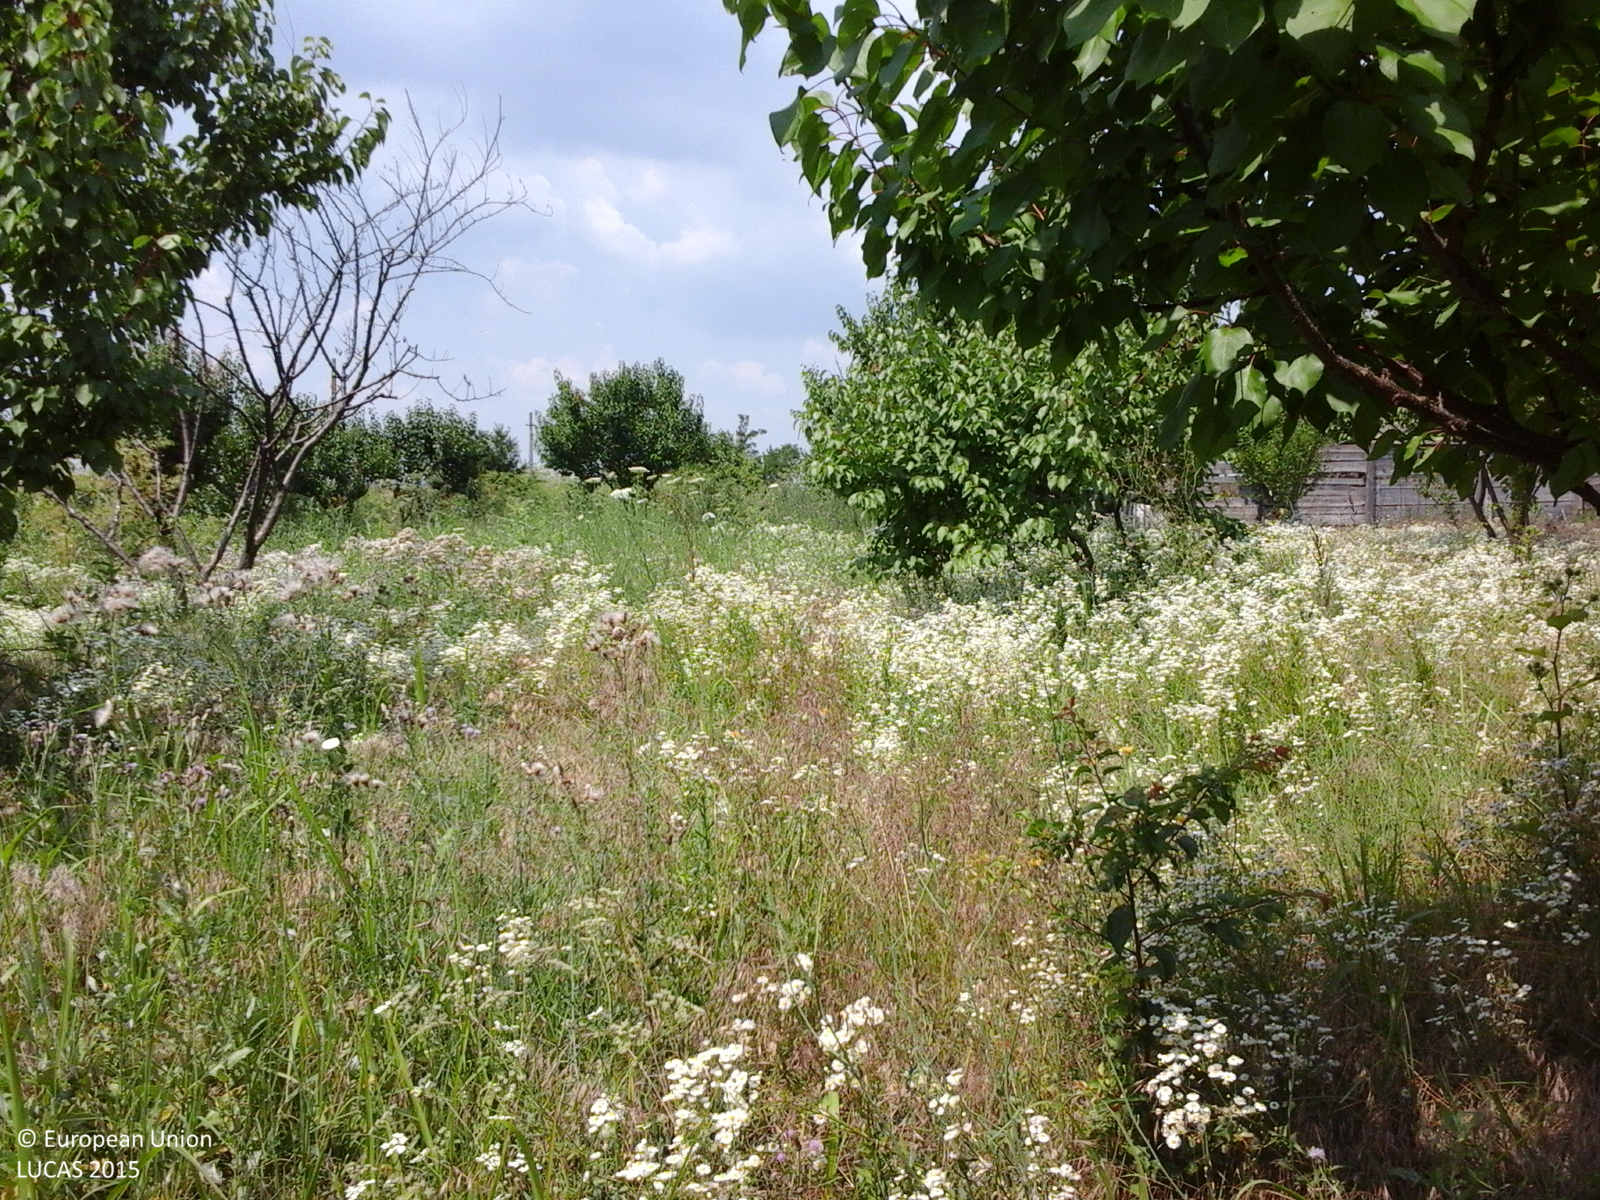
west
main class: Cropland
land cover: Other fruit trees and berries
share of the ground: 50 - 75 %
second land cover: Grassland without tree/shrub cover
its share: > 75 %
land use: Agriculture (excluding fallow land and kitchen gardens)
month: July
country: RO
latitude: 43.8422
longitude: 25.4703
